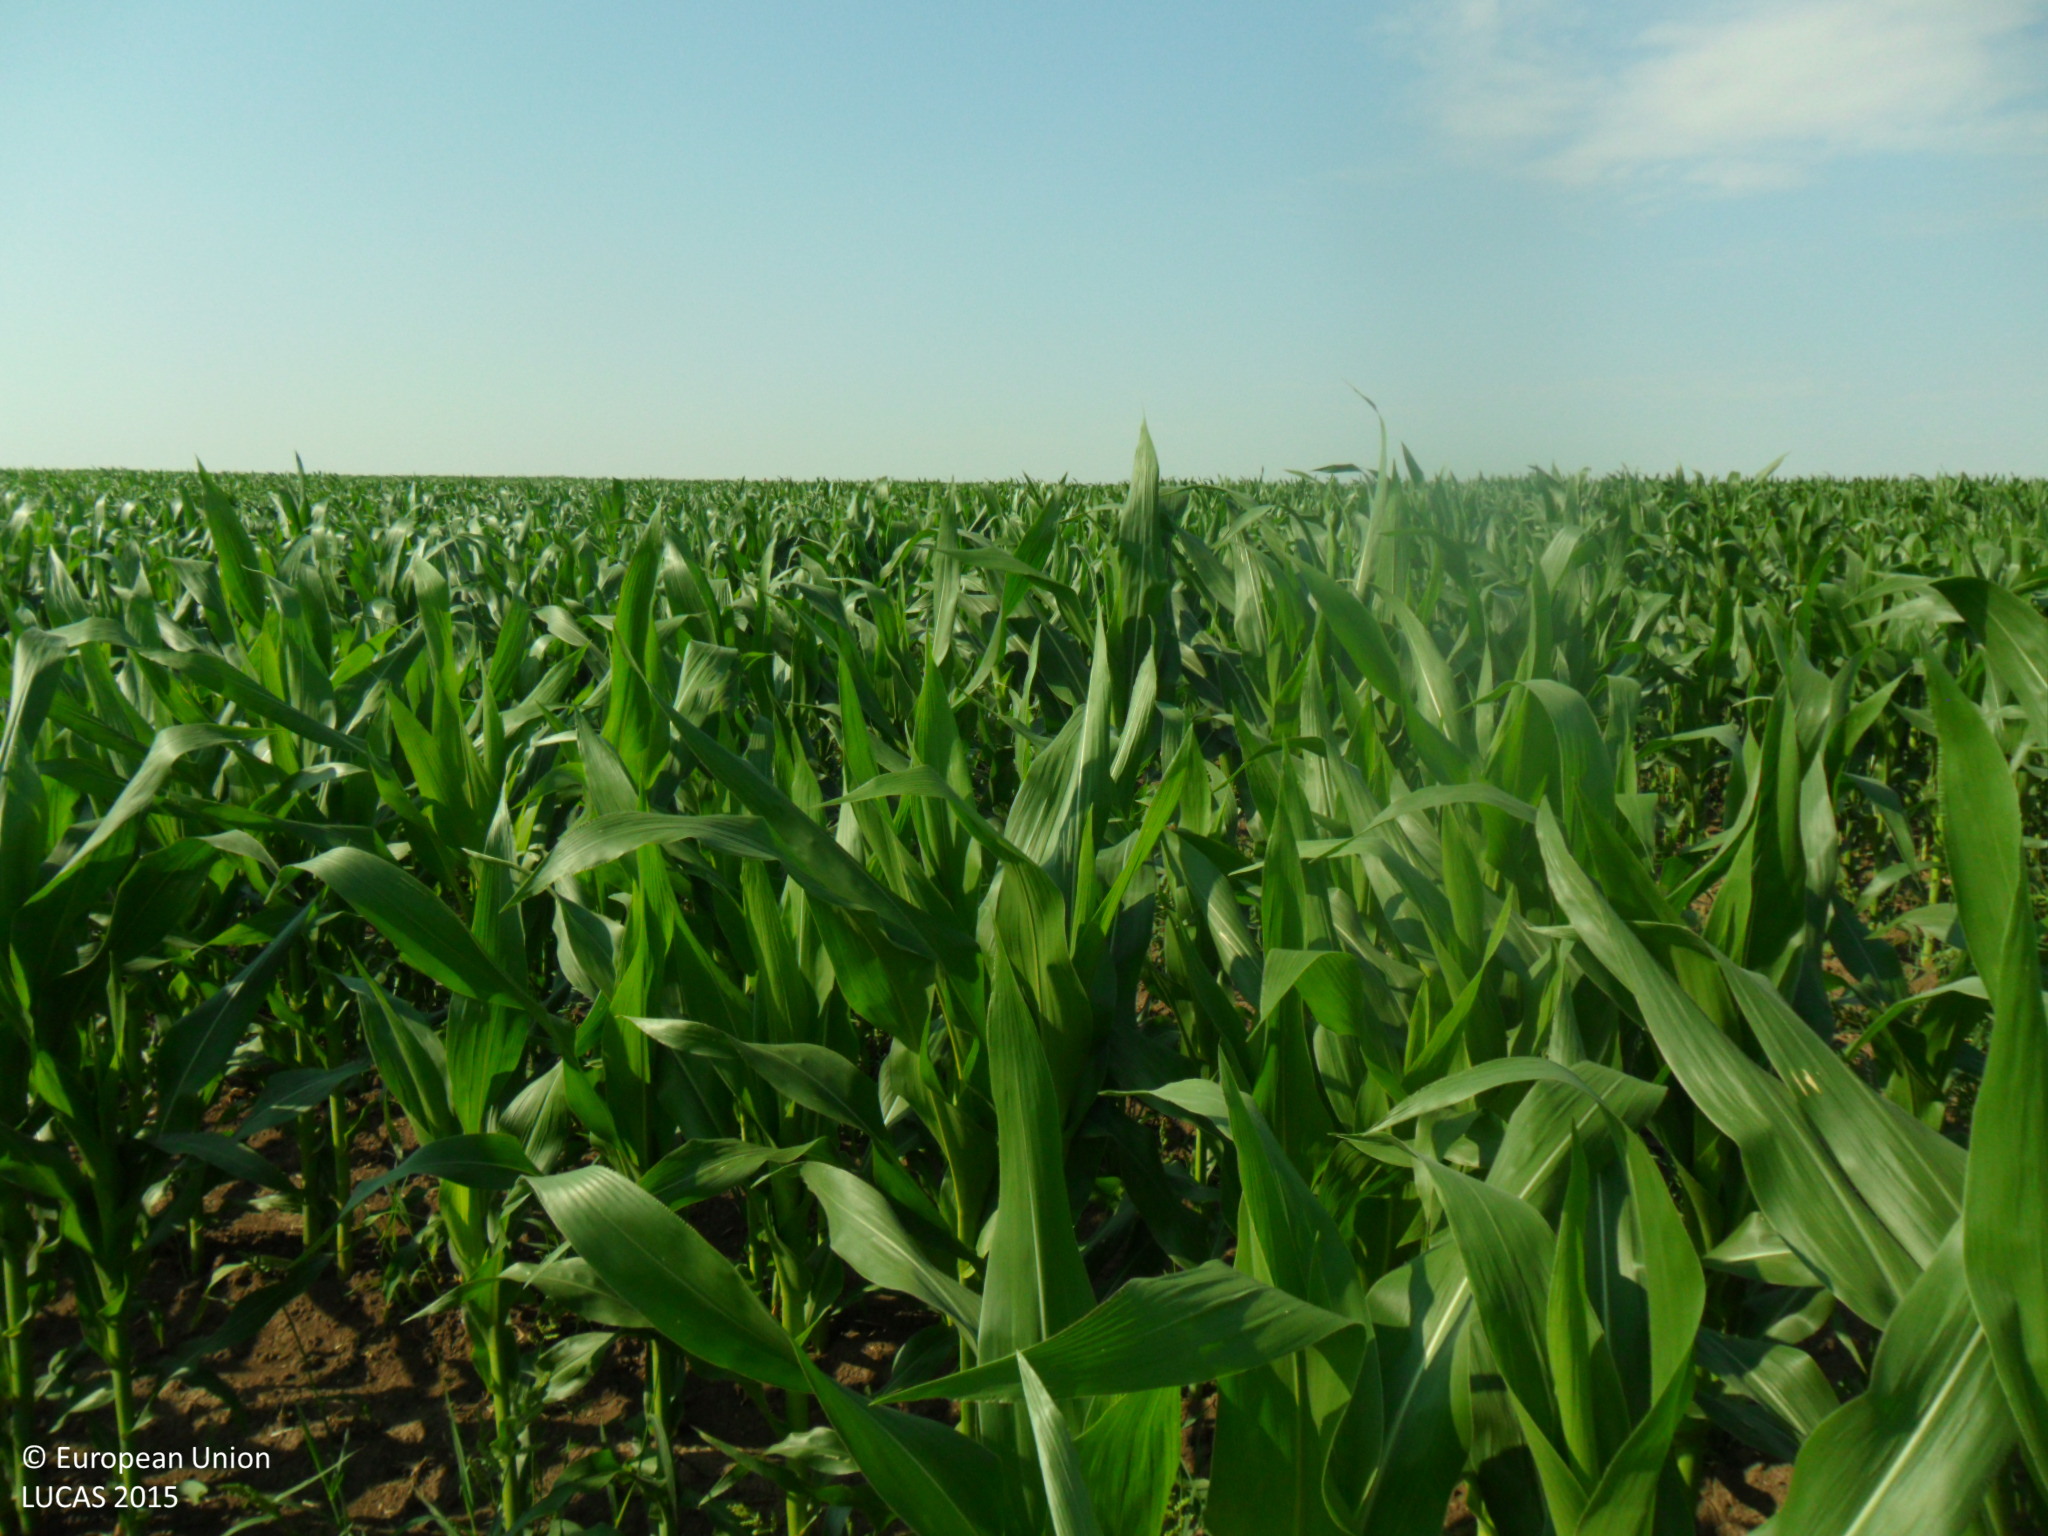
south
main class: Cropland
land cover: Maize
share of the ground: > 75 %
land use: Agriculture (excluding fallow land and kitchen gardens)
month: July
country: BG
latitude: 43.6417
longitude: 26.7359
